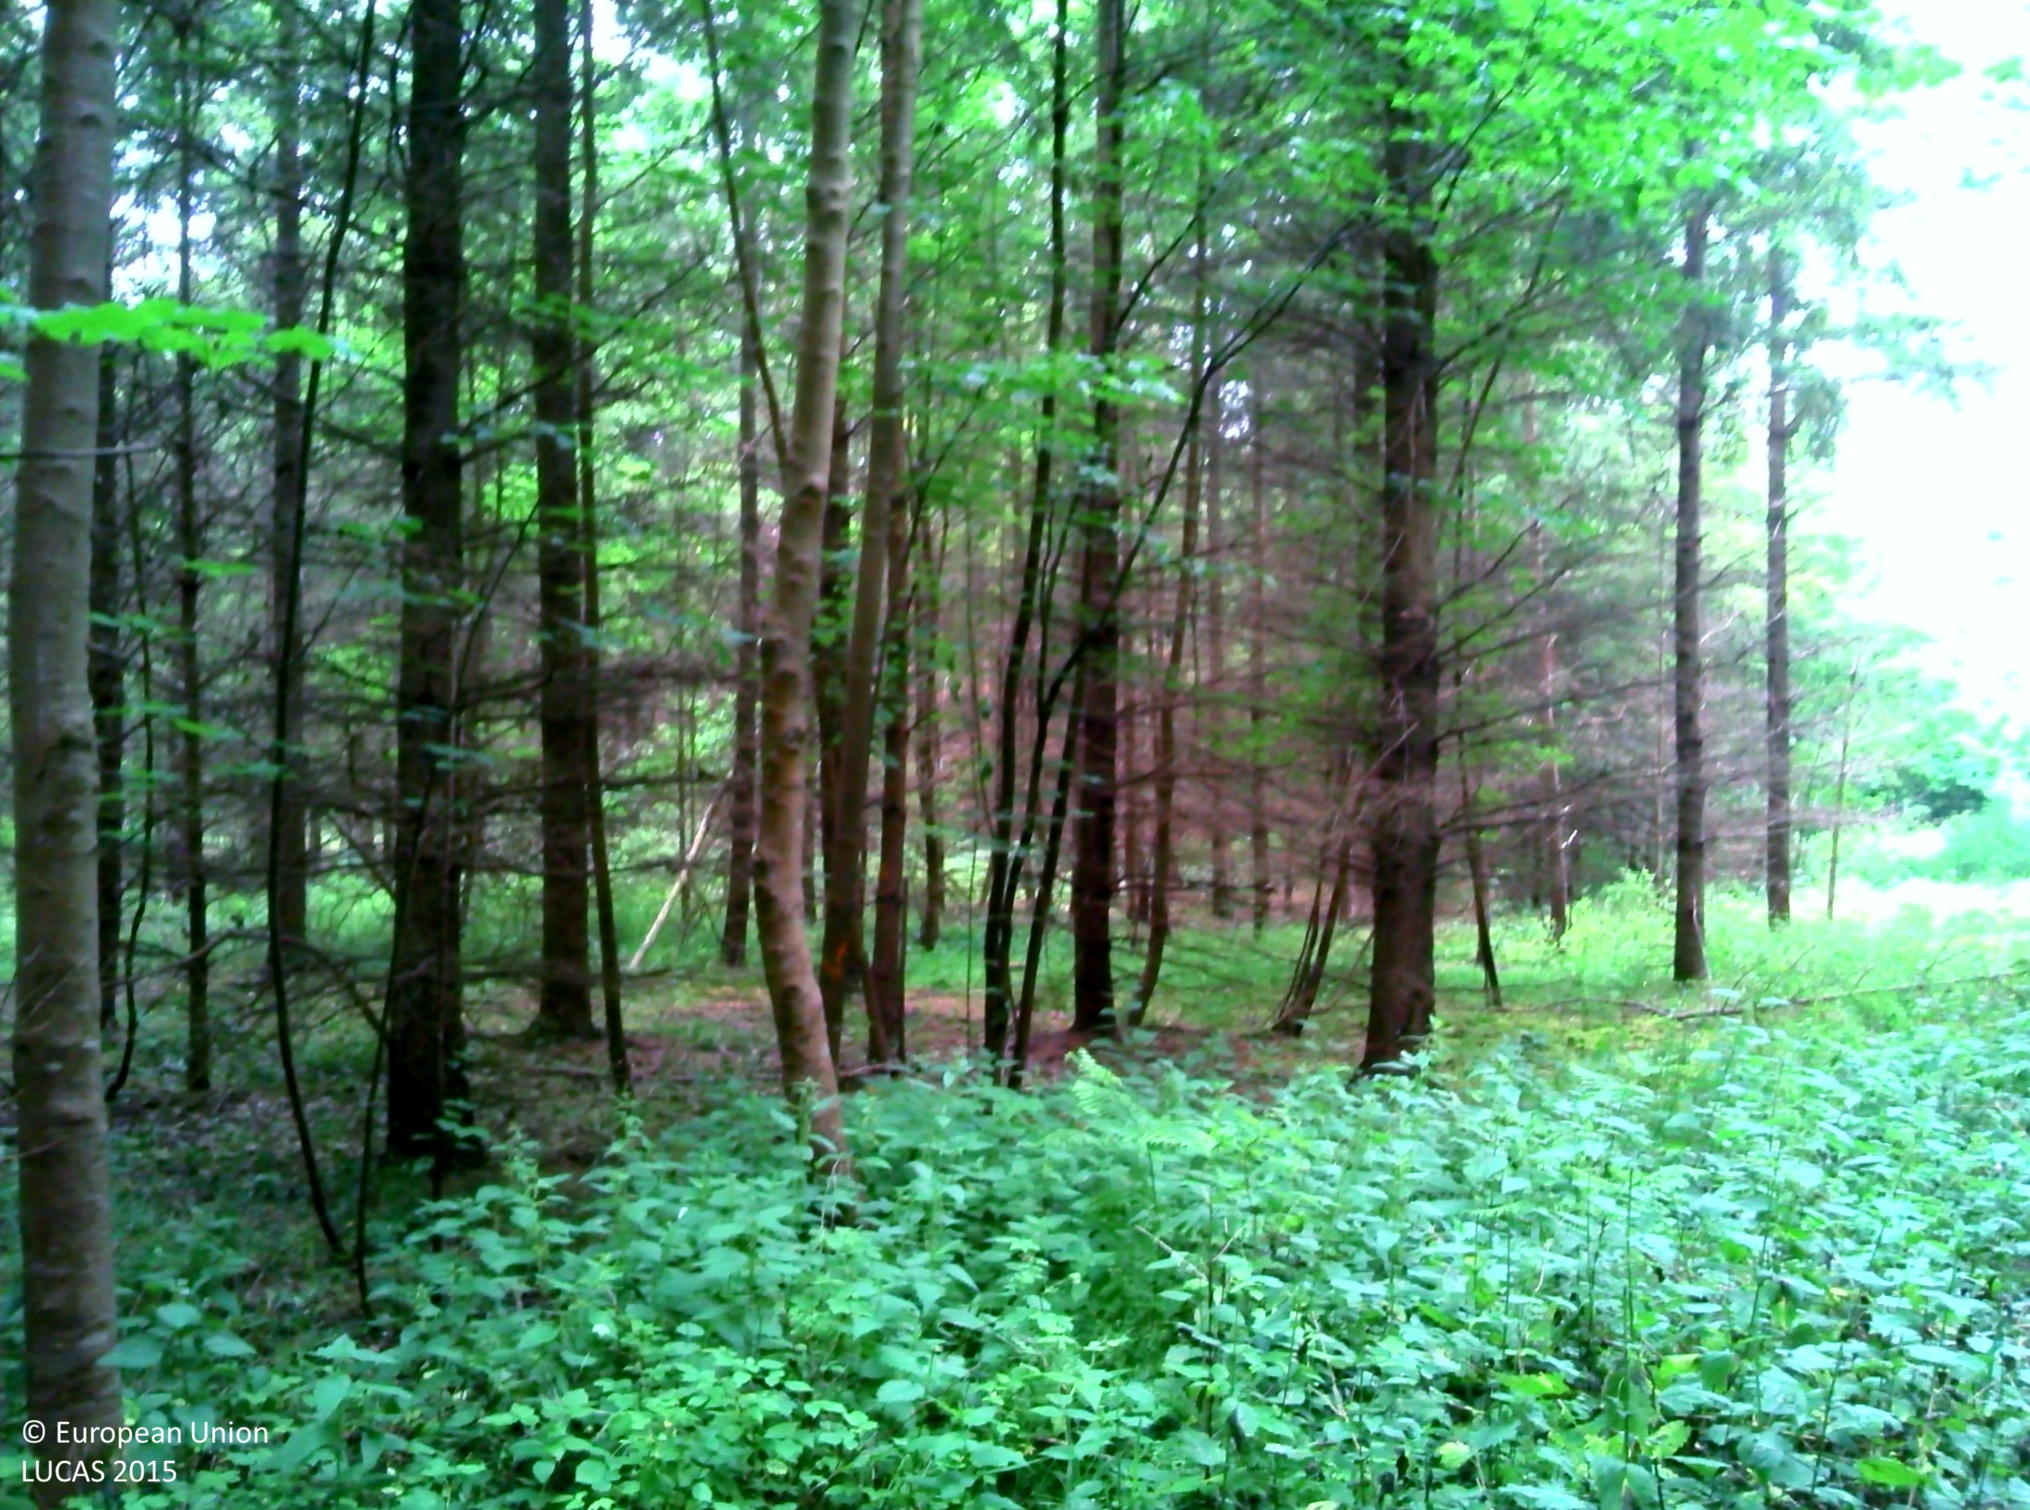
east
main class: Woodland
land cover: Spruce dominated mixed woodland
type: hemiboreal forest and nemoral coniferous forest and mixed broadleaved-coniferous forest
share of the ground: > 75 %
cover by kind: coniferous forest trees 55 %, broadleaved forest trees 30 %, shrubs 5 %, herbaceous plants 5 %, lichens and mosses 5 %
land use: Forestry
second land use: Sport
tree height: > 5 m
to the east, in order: Spruce dominated mixed woodland; Tracks; Spruce dominated mixed woodland; Shrubland with sparse tree cover; Spruce dominated mixed woodland; Shrubland with sparse tree cover
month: June
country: FR
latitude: 49.3813
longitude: 2.8409
